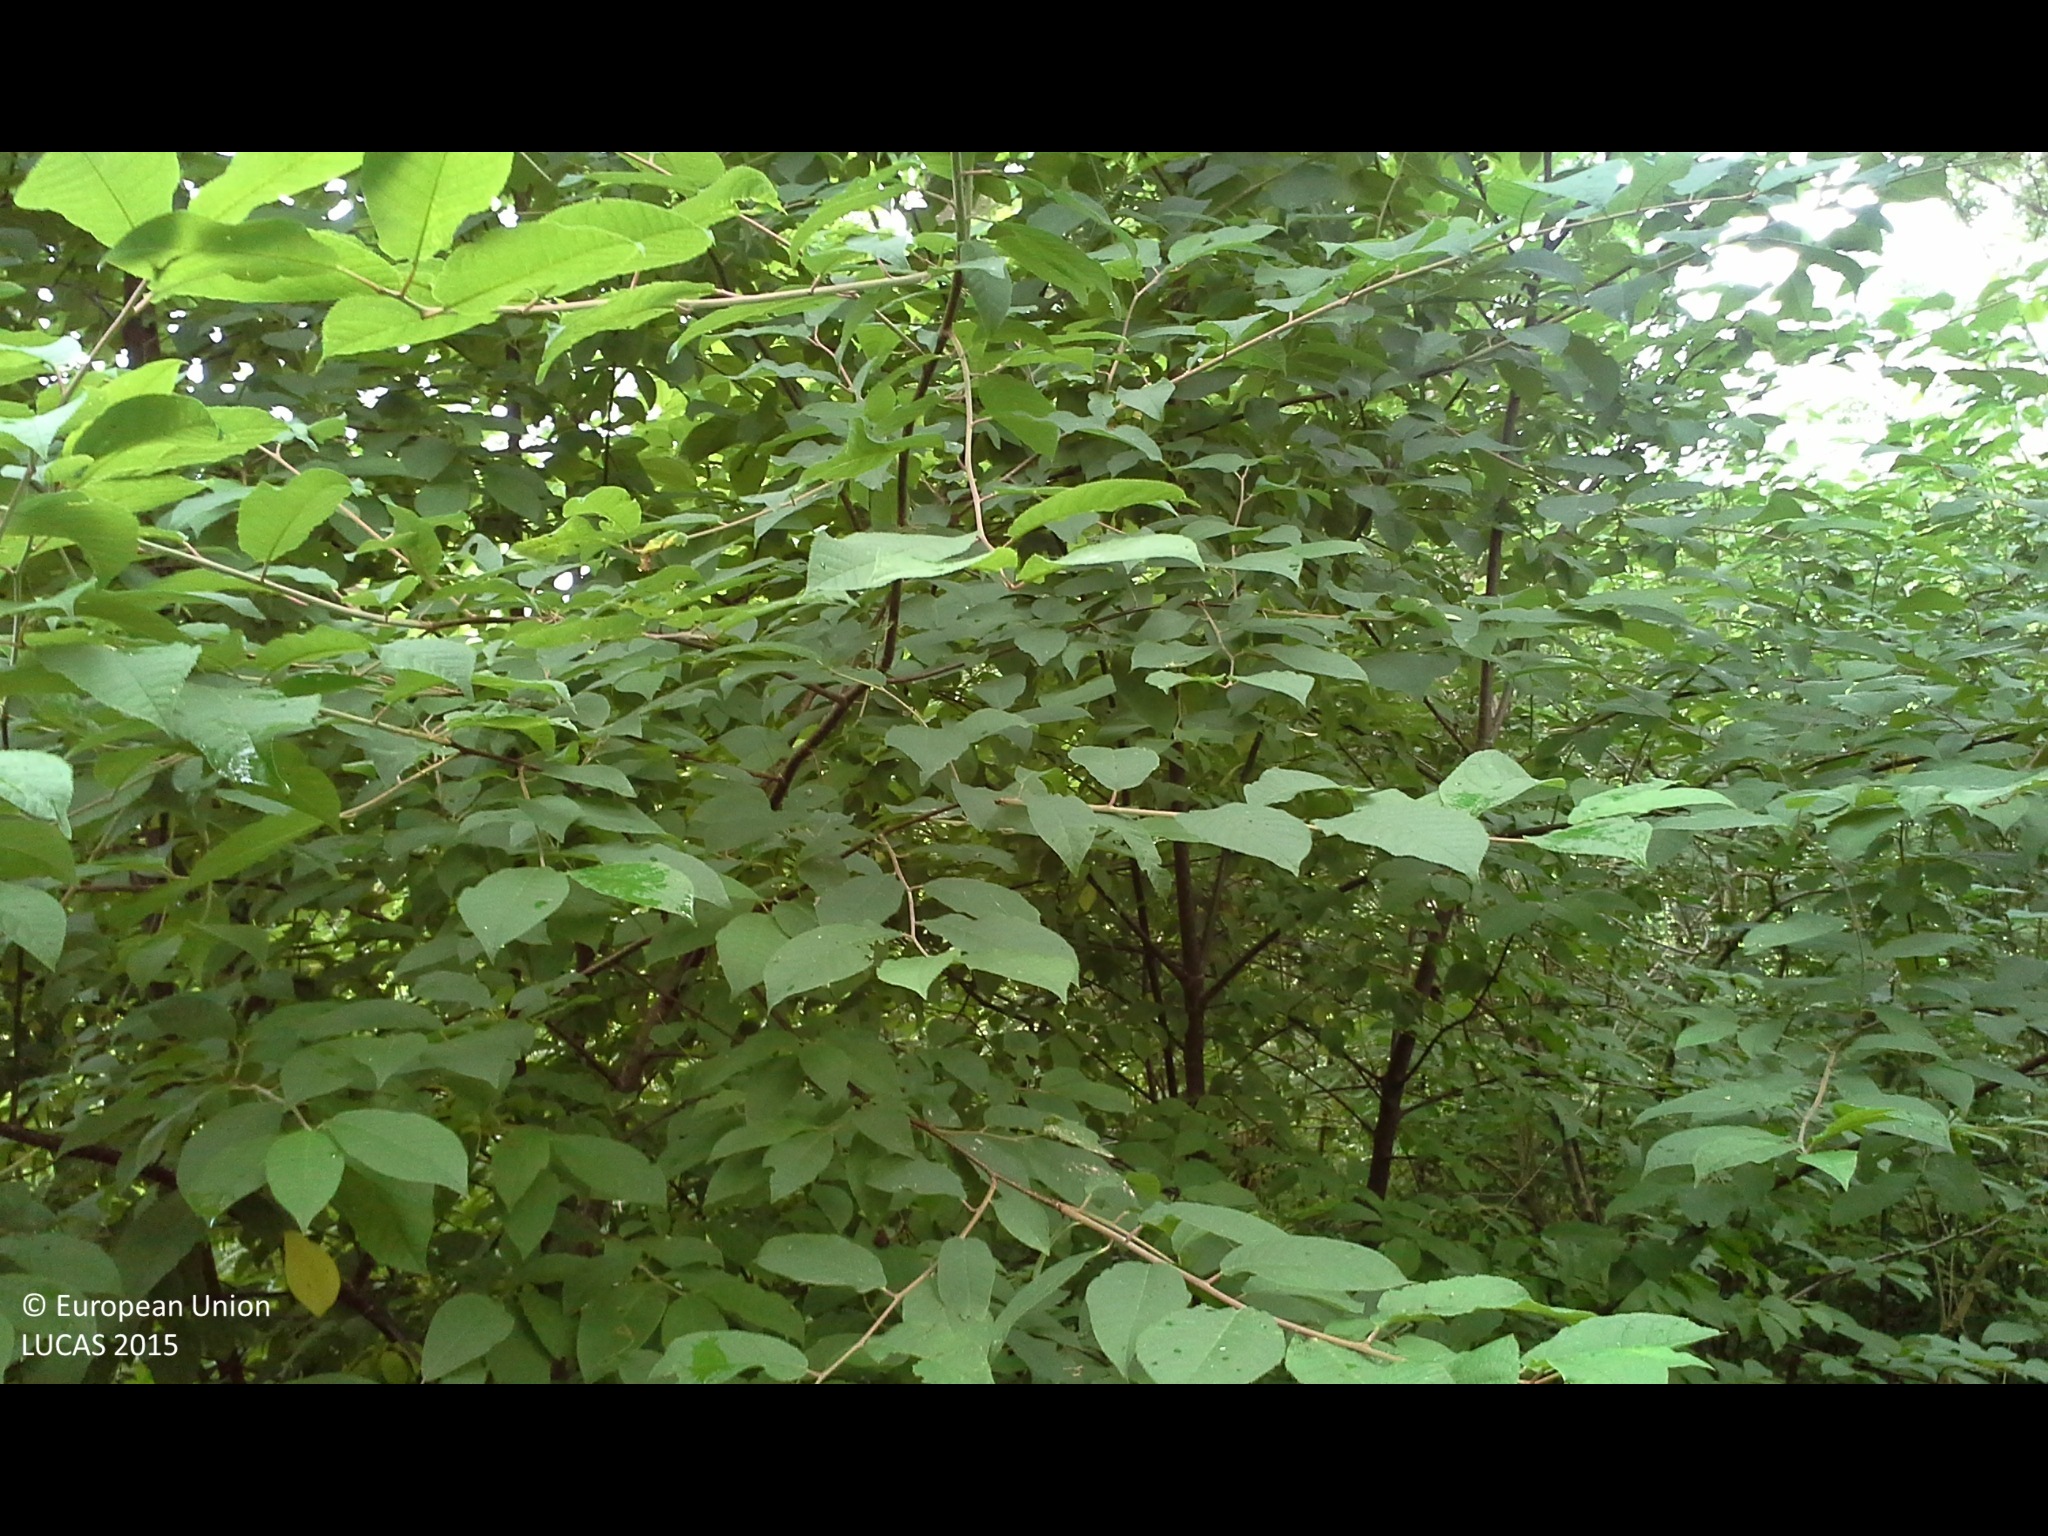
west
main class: Woodland
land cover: Broadleaved woodland
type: floodplain forest
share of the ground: > 75 %
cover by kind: broadleaved forest trees 80 %, shrubs 20 %
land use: Forestry
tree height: > 5 m
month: May
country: AT
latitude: 48.1602
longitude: 14.2348
